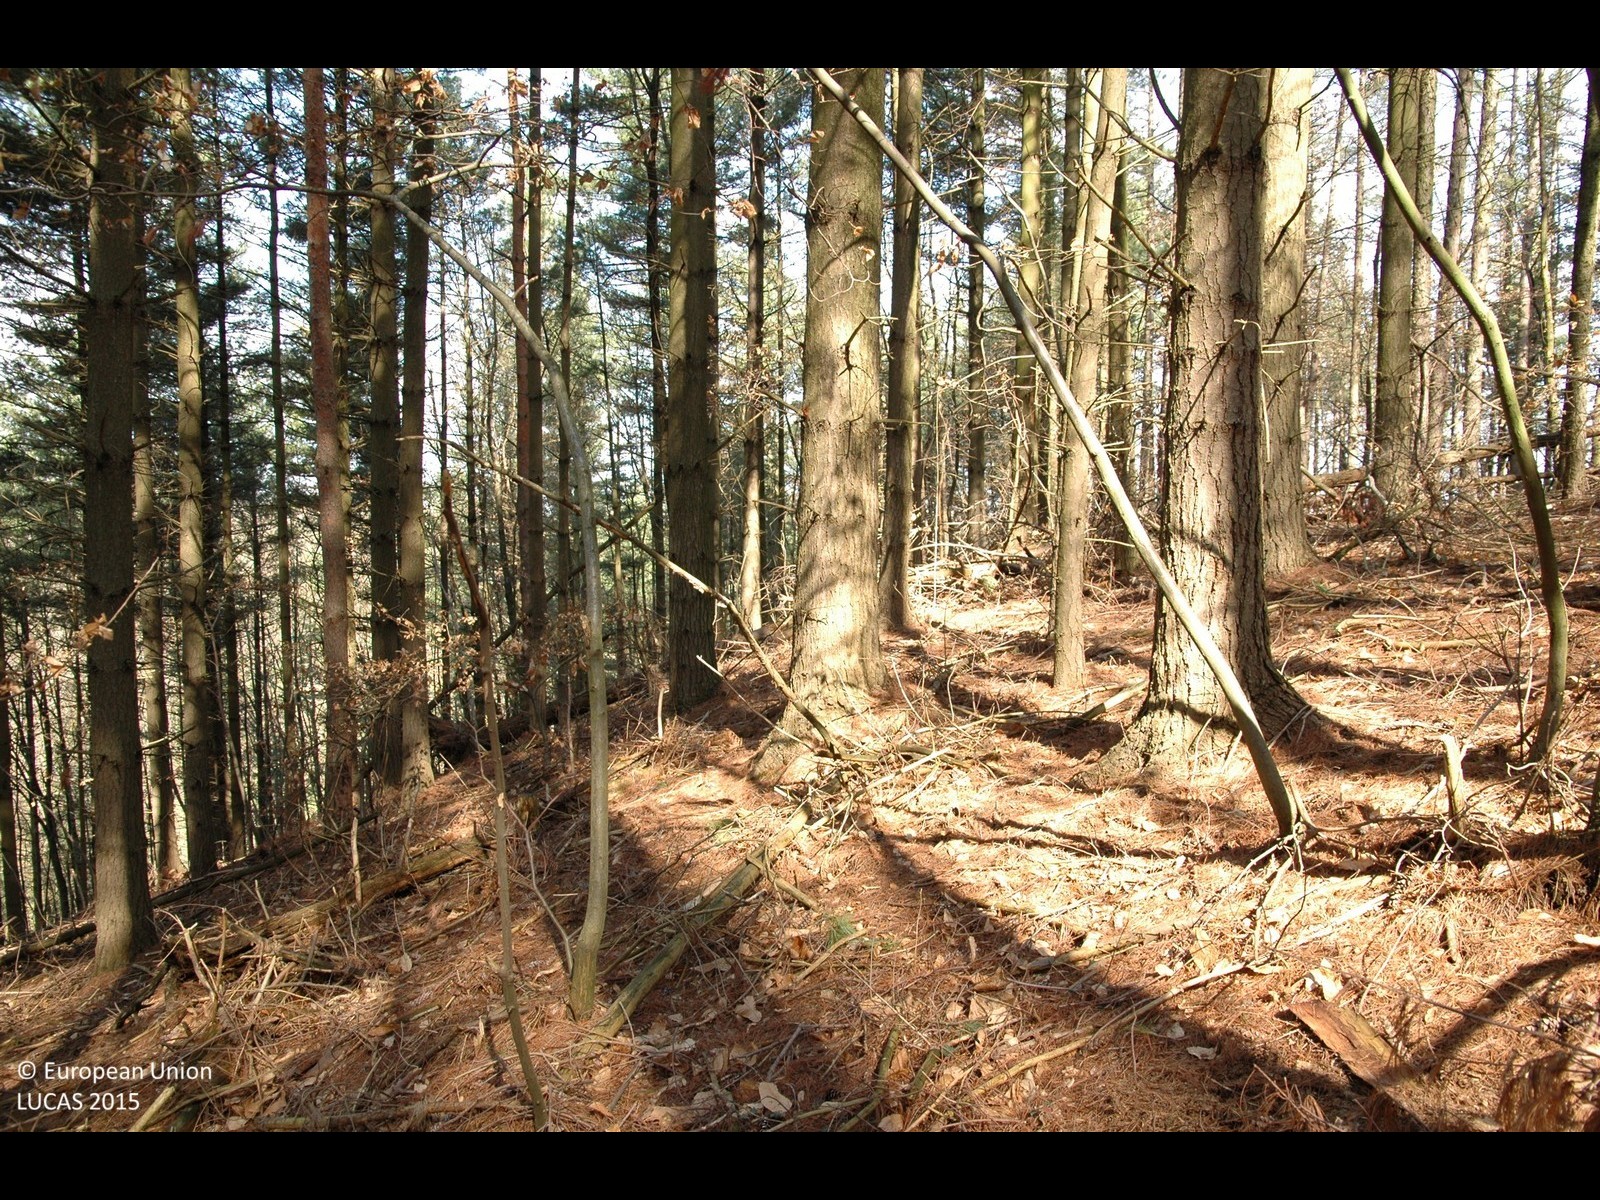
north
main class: Woodland
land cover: Pine dominated coniferous woodland
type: hemiboreal forest and nemoral coniferous forest and mixed broadleaved-coniferous forest
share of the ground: > 75 %
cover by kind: coniferous forest trees 95 %, broadleaved forest trees 5 %
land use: Forestry
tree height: > 5 m
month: March
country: HR
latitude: 46.3371
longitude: 16.1447
